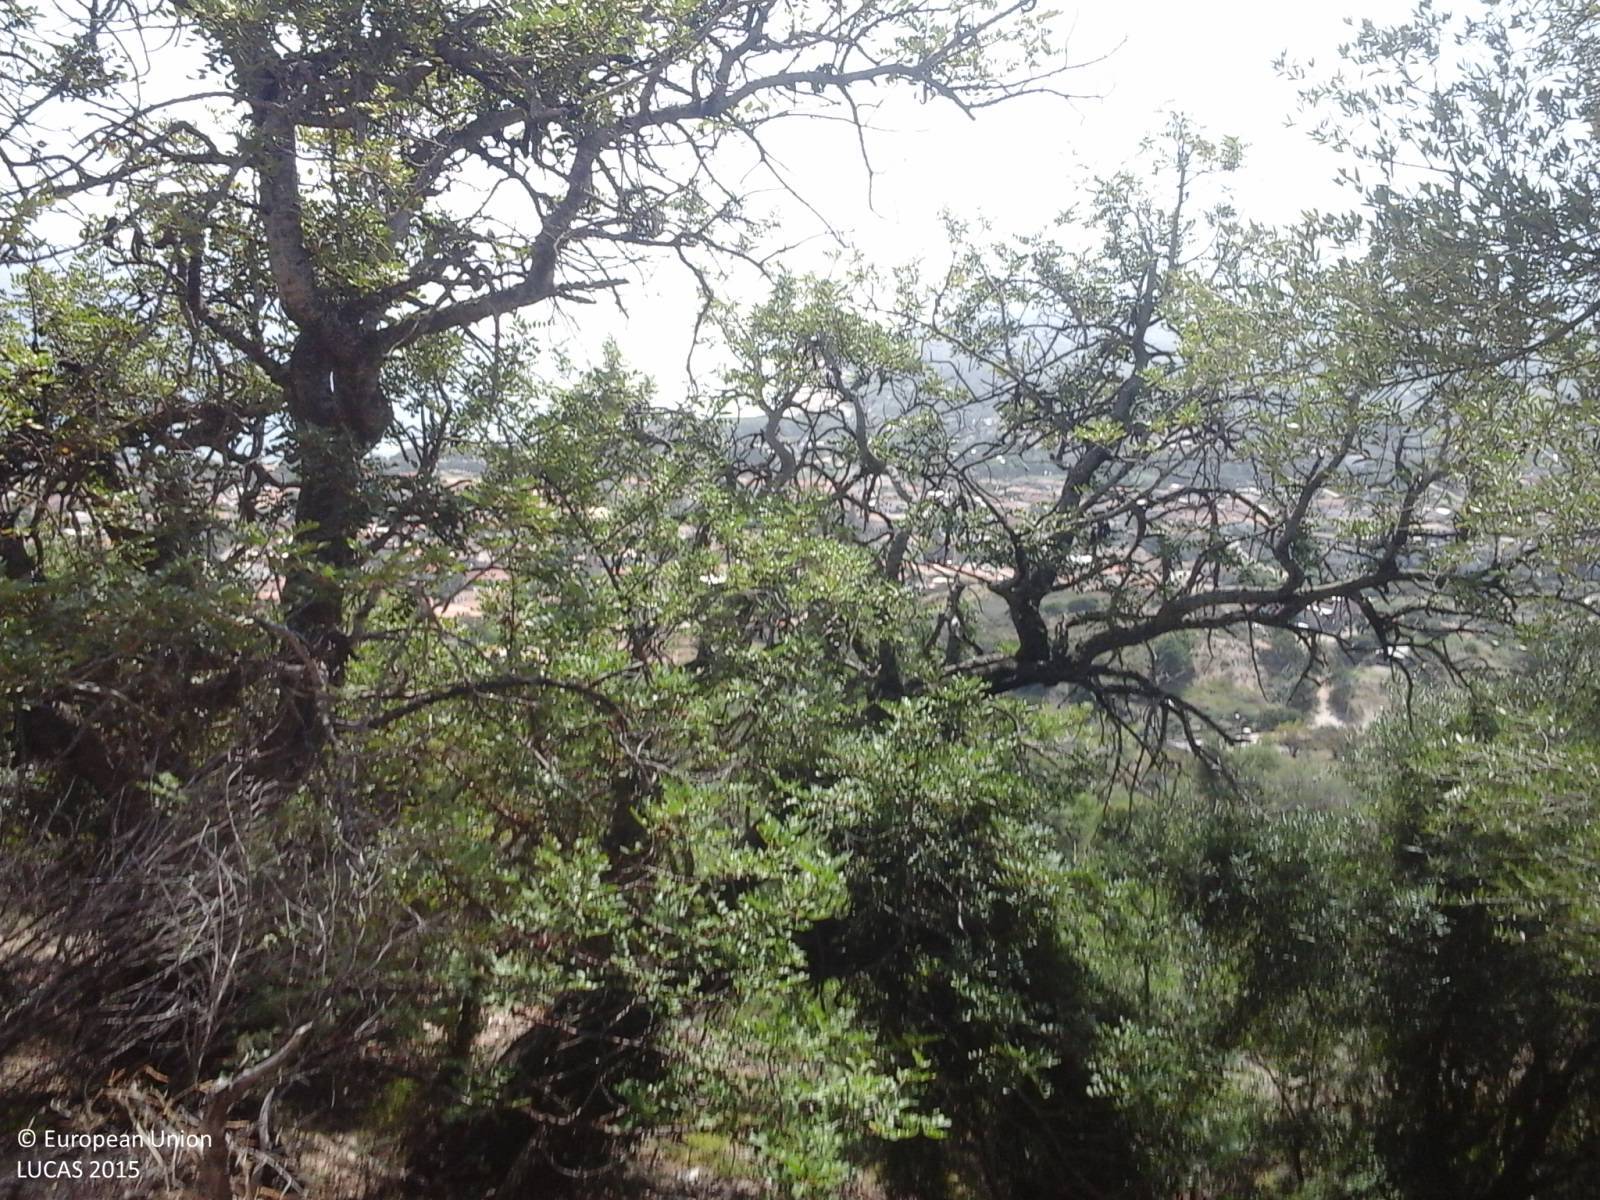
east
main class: Woodland
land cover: Broadleaved woodland
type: broadleaved evergreen forest
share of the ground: > 75 %
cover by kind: broadleaved forest trees 50 %, shrubs 20 %, unconsolidated bare surface 20 %, herbaceous plants 10 %
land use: Semi-natural and natural areas not in use
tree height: > 5 m
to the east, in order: Broadleaved woodland; Paved roads, cycling and walking lanes; Abandoned hedges; Paved roads, cycling and walking lanes; Shrubland with sparse tree cover
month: September
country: IT
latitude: 39.9952
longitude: 9.6855
